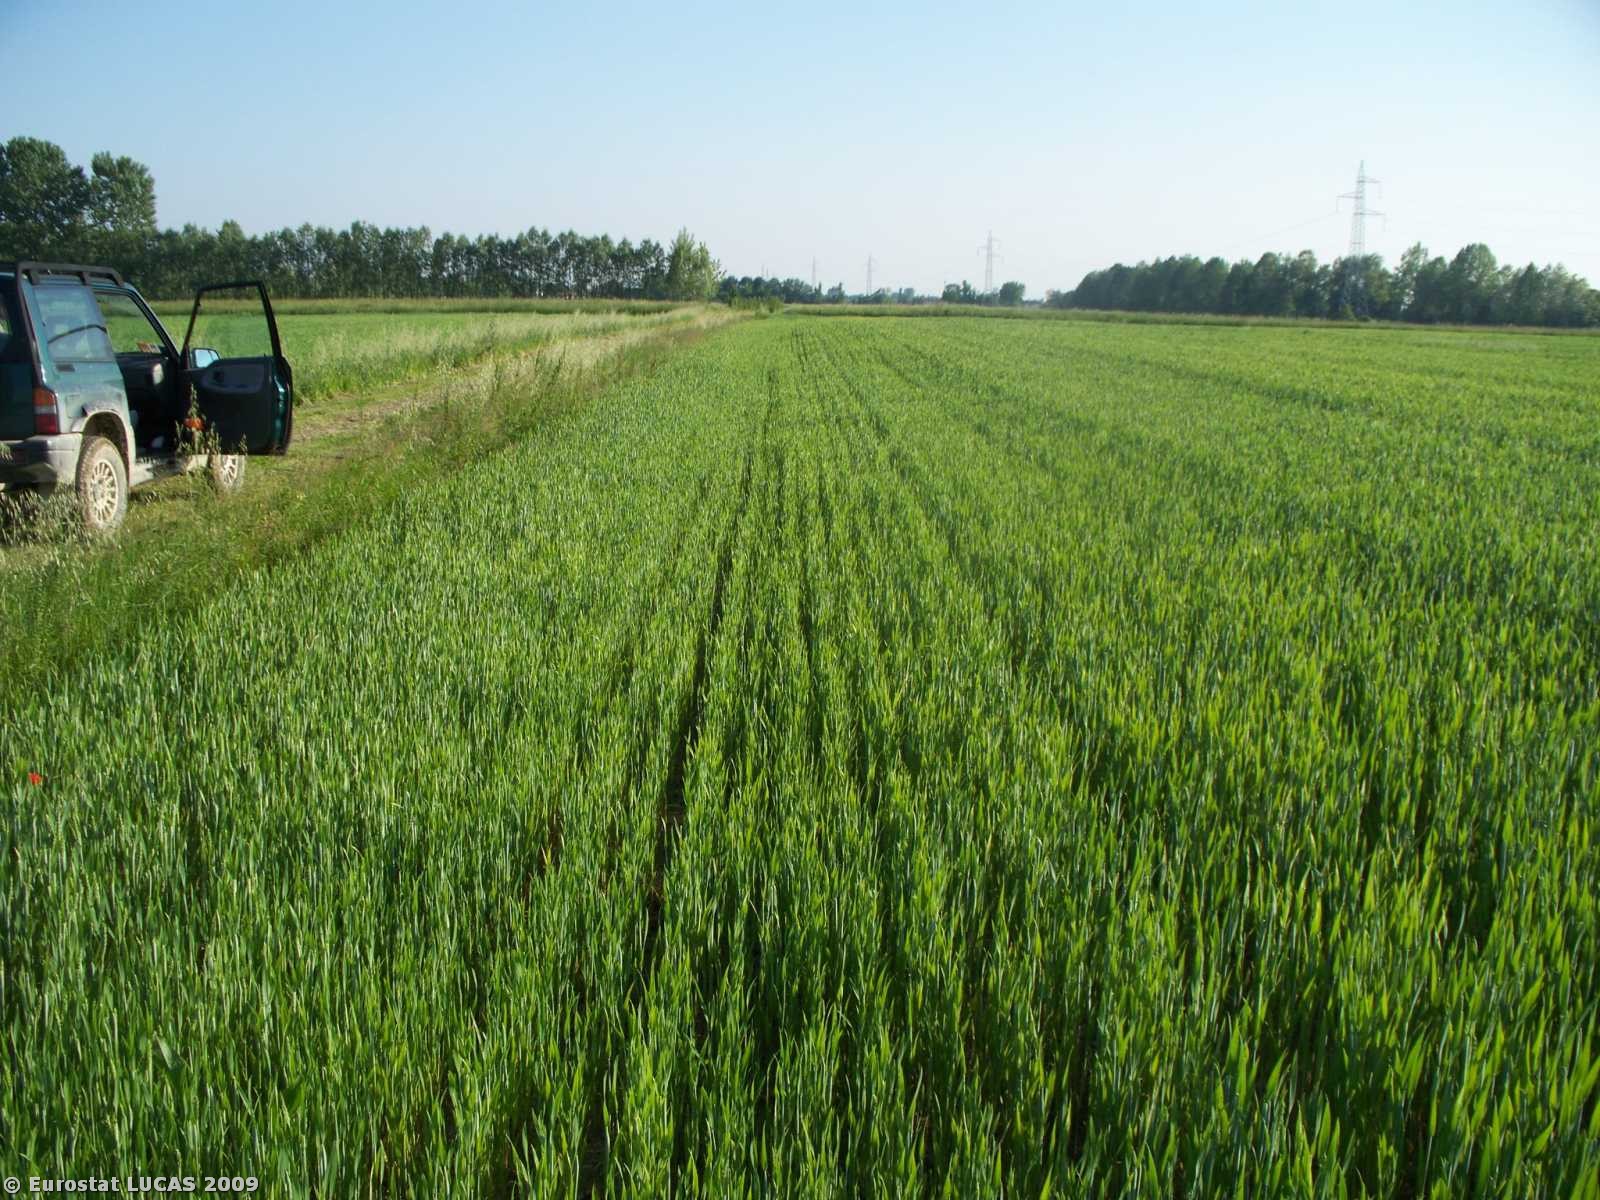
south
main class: Cropland
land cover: Common wheat
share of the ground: > 75 %
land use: Agriculture (excluding fallow land and kitchen gardens)
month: May
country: IT
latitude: 45.4844
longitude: 12.0566
